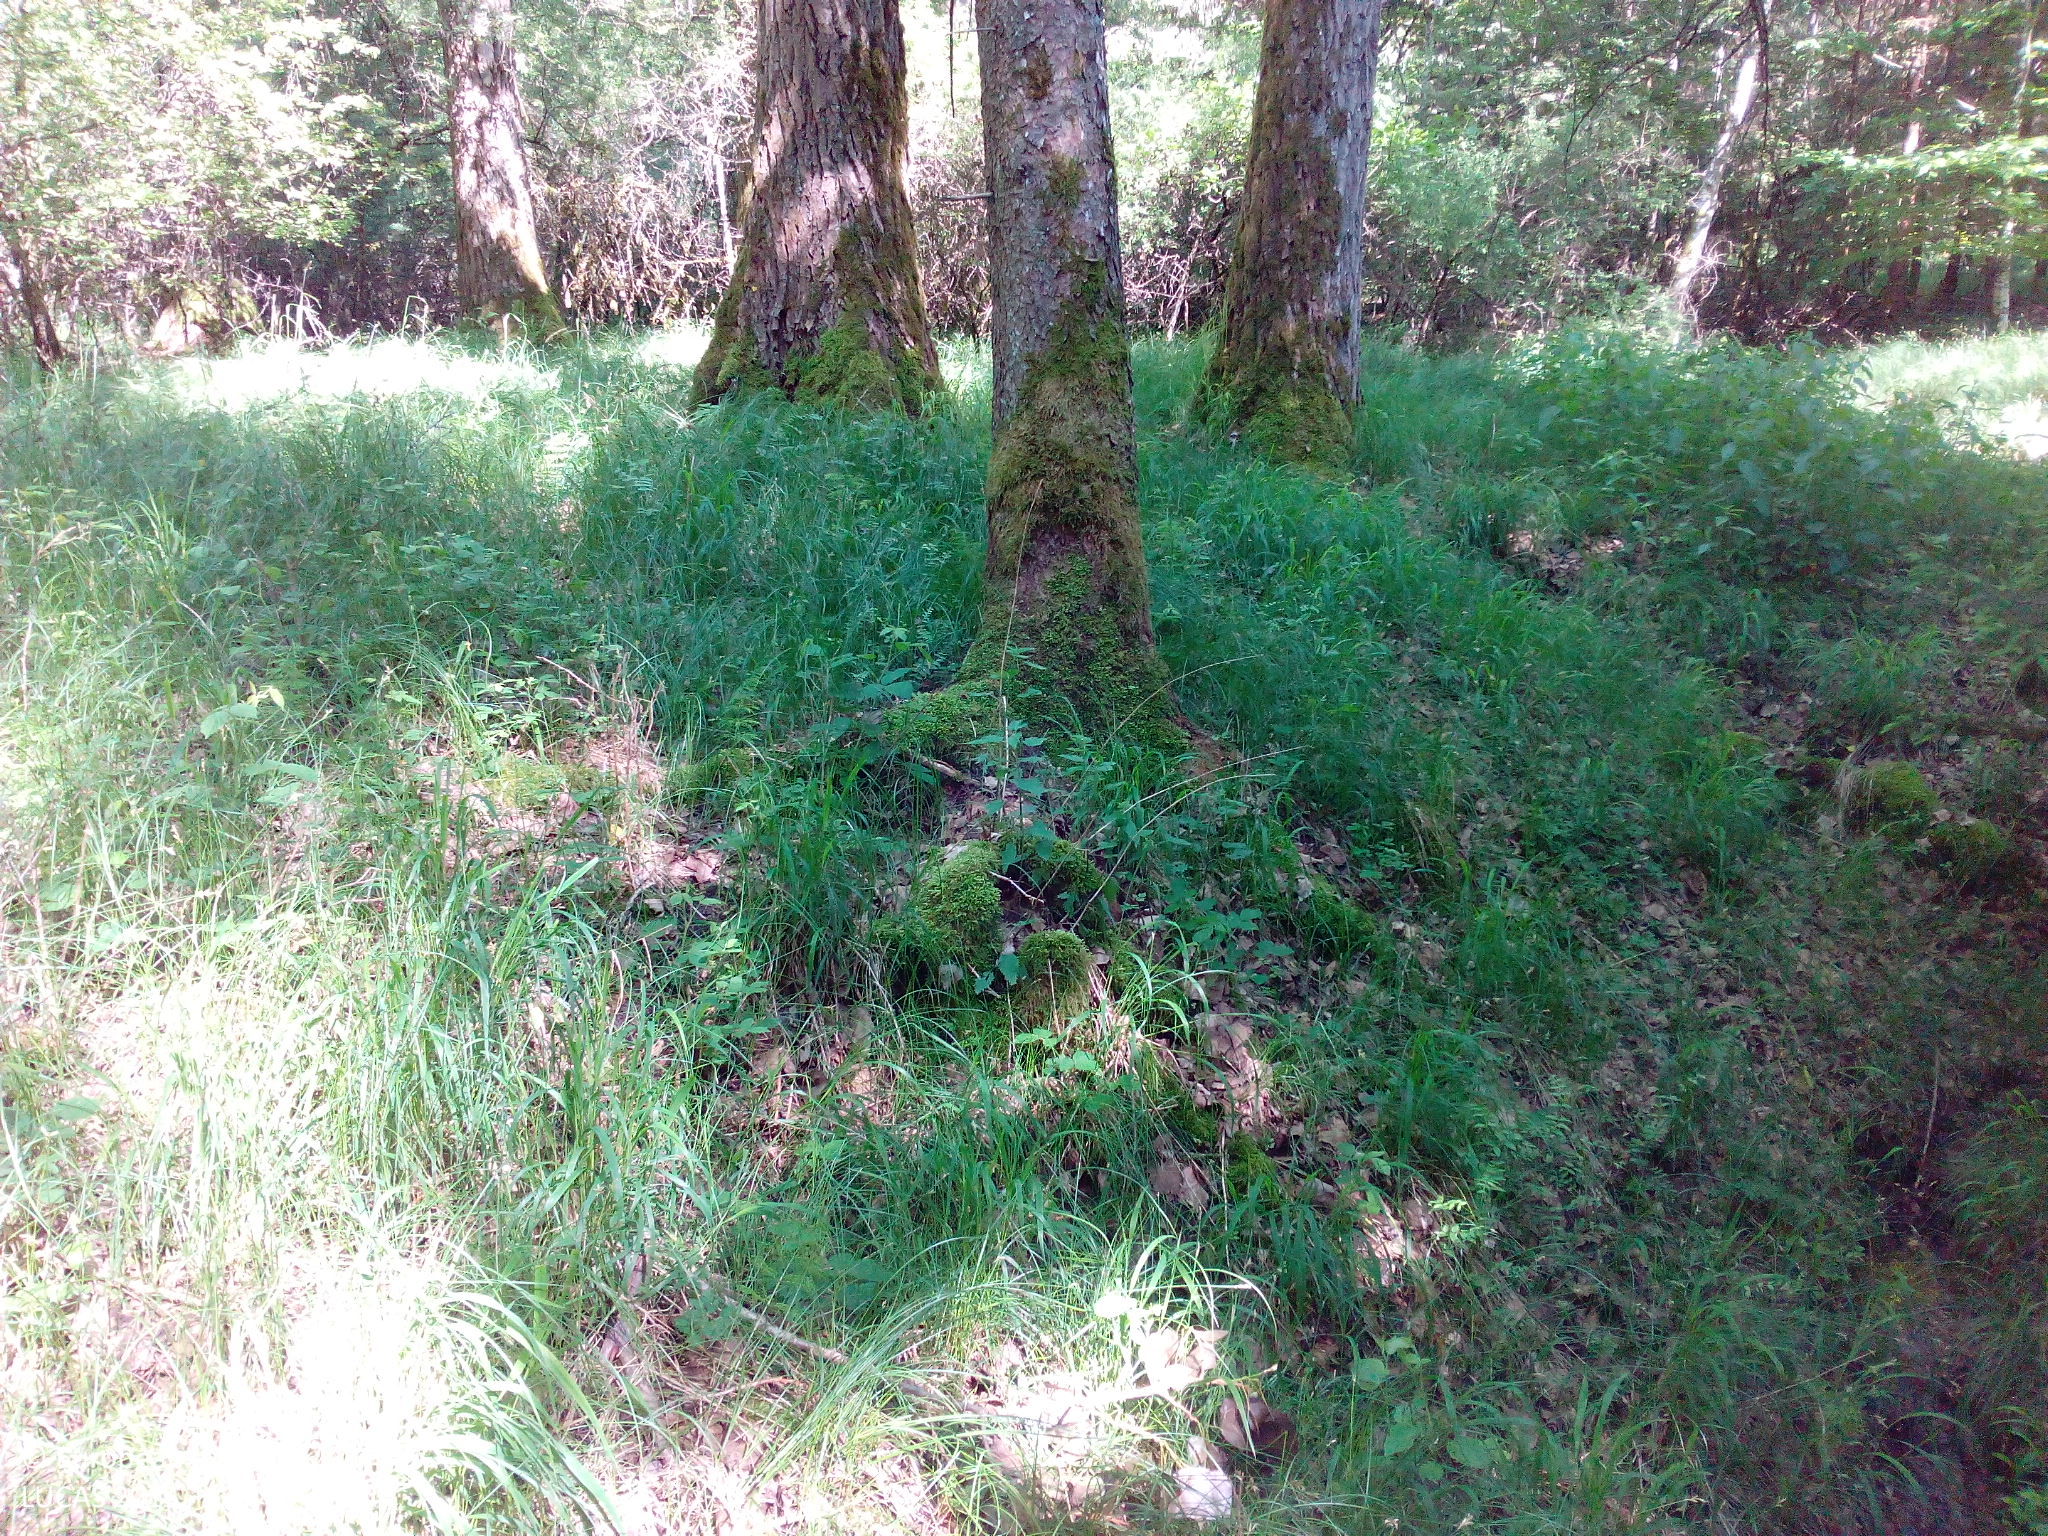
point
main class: Woodland
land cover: Broadleaved woodland
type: mire and swamp forests
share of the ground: > 75 %
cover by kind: broadleaved forest trees 70 %, coniferous forest trees 10 %, shrubs 10 %, herbaceous plants 10 %
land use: Forestry
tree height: > 5 m
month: June
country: DE
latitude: 48.5413
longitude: 12.3153
